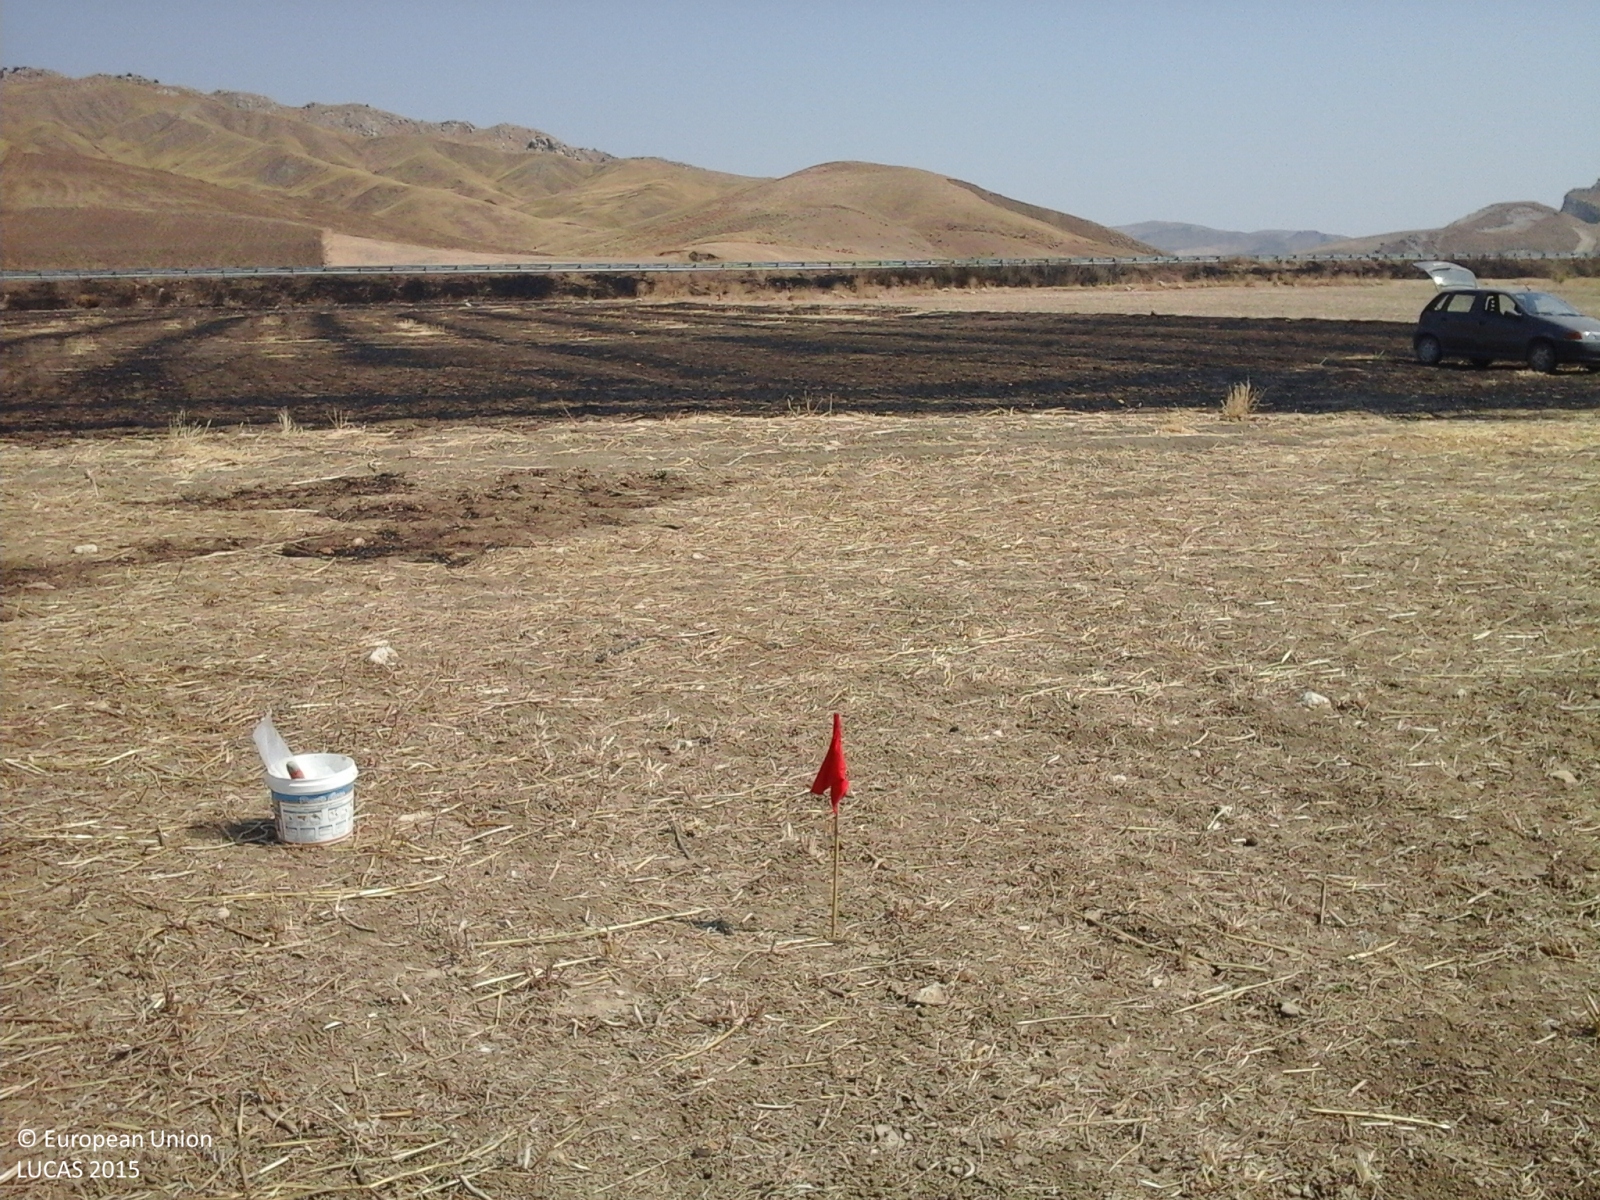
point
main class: Cropland
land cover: Durum wheat
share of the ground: > 75 %
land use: Agriculture (excluding fallow land and kitchen gardens)
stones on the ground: < 10 %
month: July
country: IT
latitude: 37.3143
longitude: 14.0872
